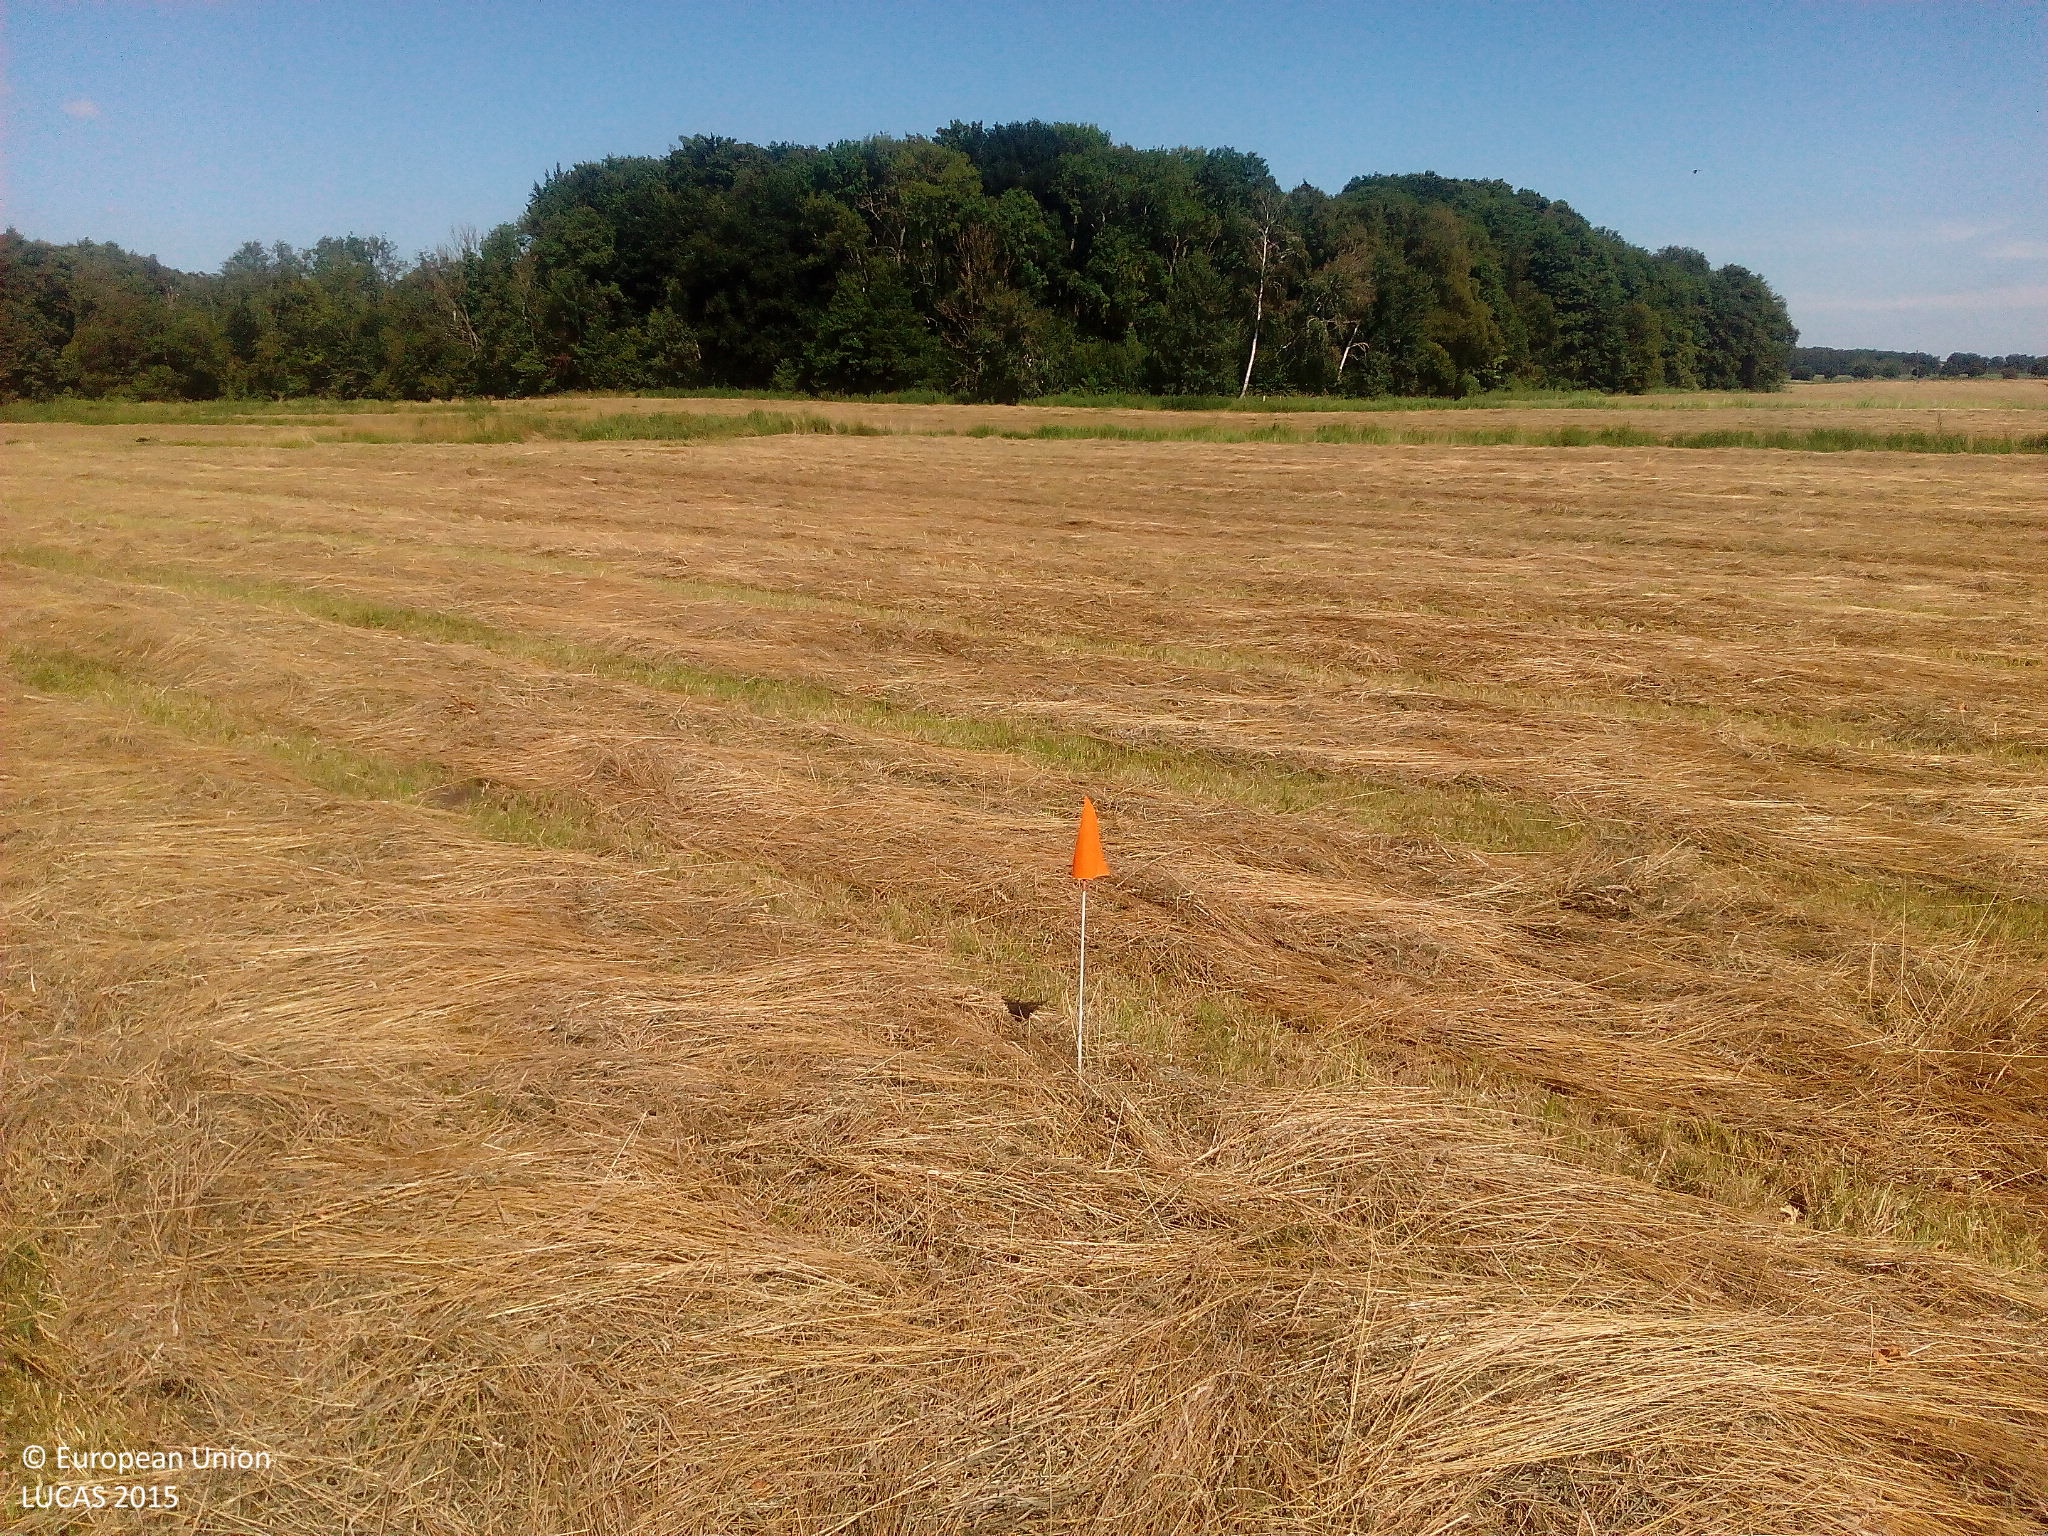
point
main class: Grassland
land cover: Grassland without tree/shrub cover
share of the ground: > 75 %
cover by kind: herbaceous plants 100 %
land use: Agriculture (excluding fallow land and kitchen gardens)
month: August
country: DE
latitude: 53.4849
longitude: 12.4557
